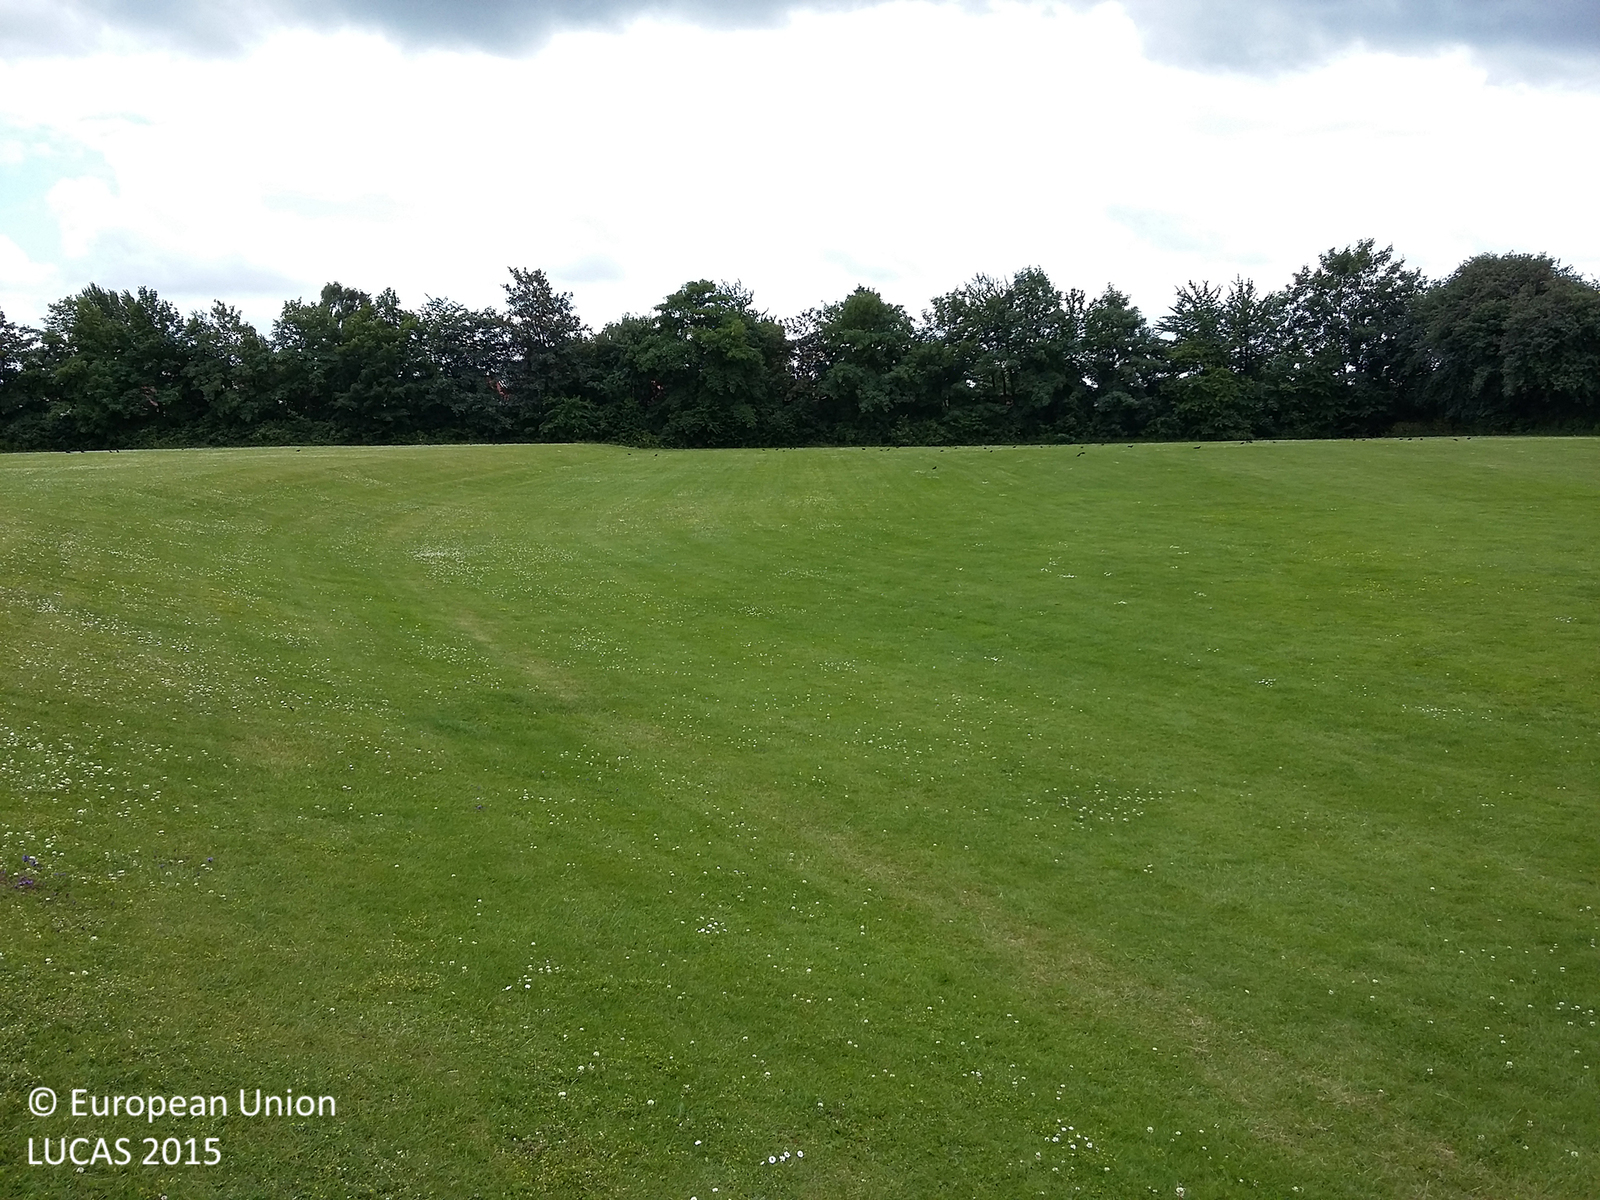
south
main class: Grassland
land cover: Grassland without tree/shrub cover
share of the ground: > 75 %
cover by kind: herbaceous plants 100 %
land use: Sport
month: July
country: DK
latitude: 55.2406
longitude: 11.7758
